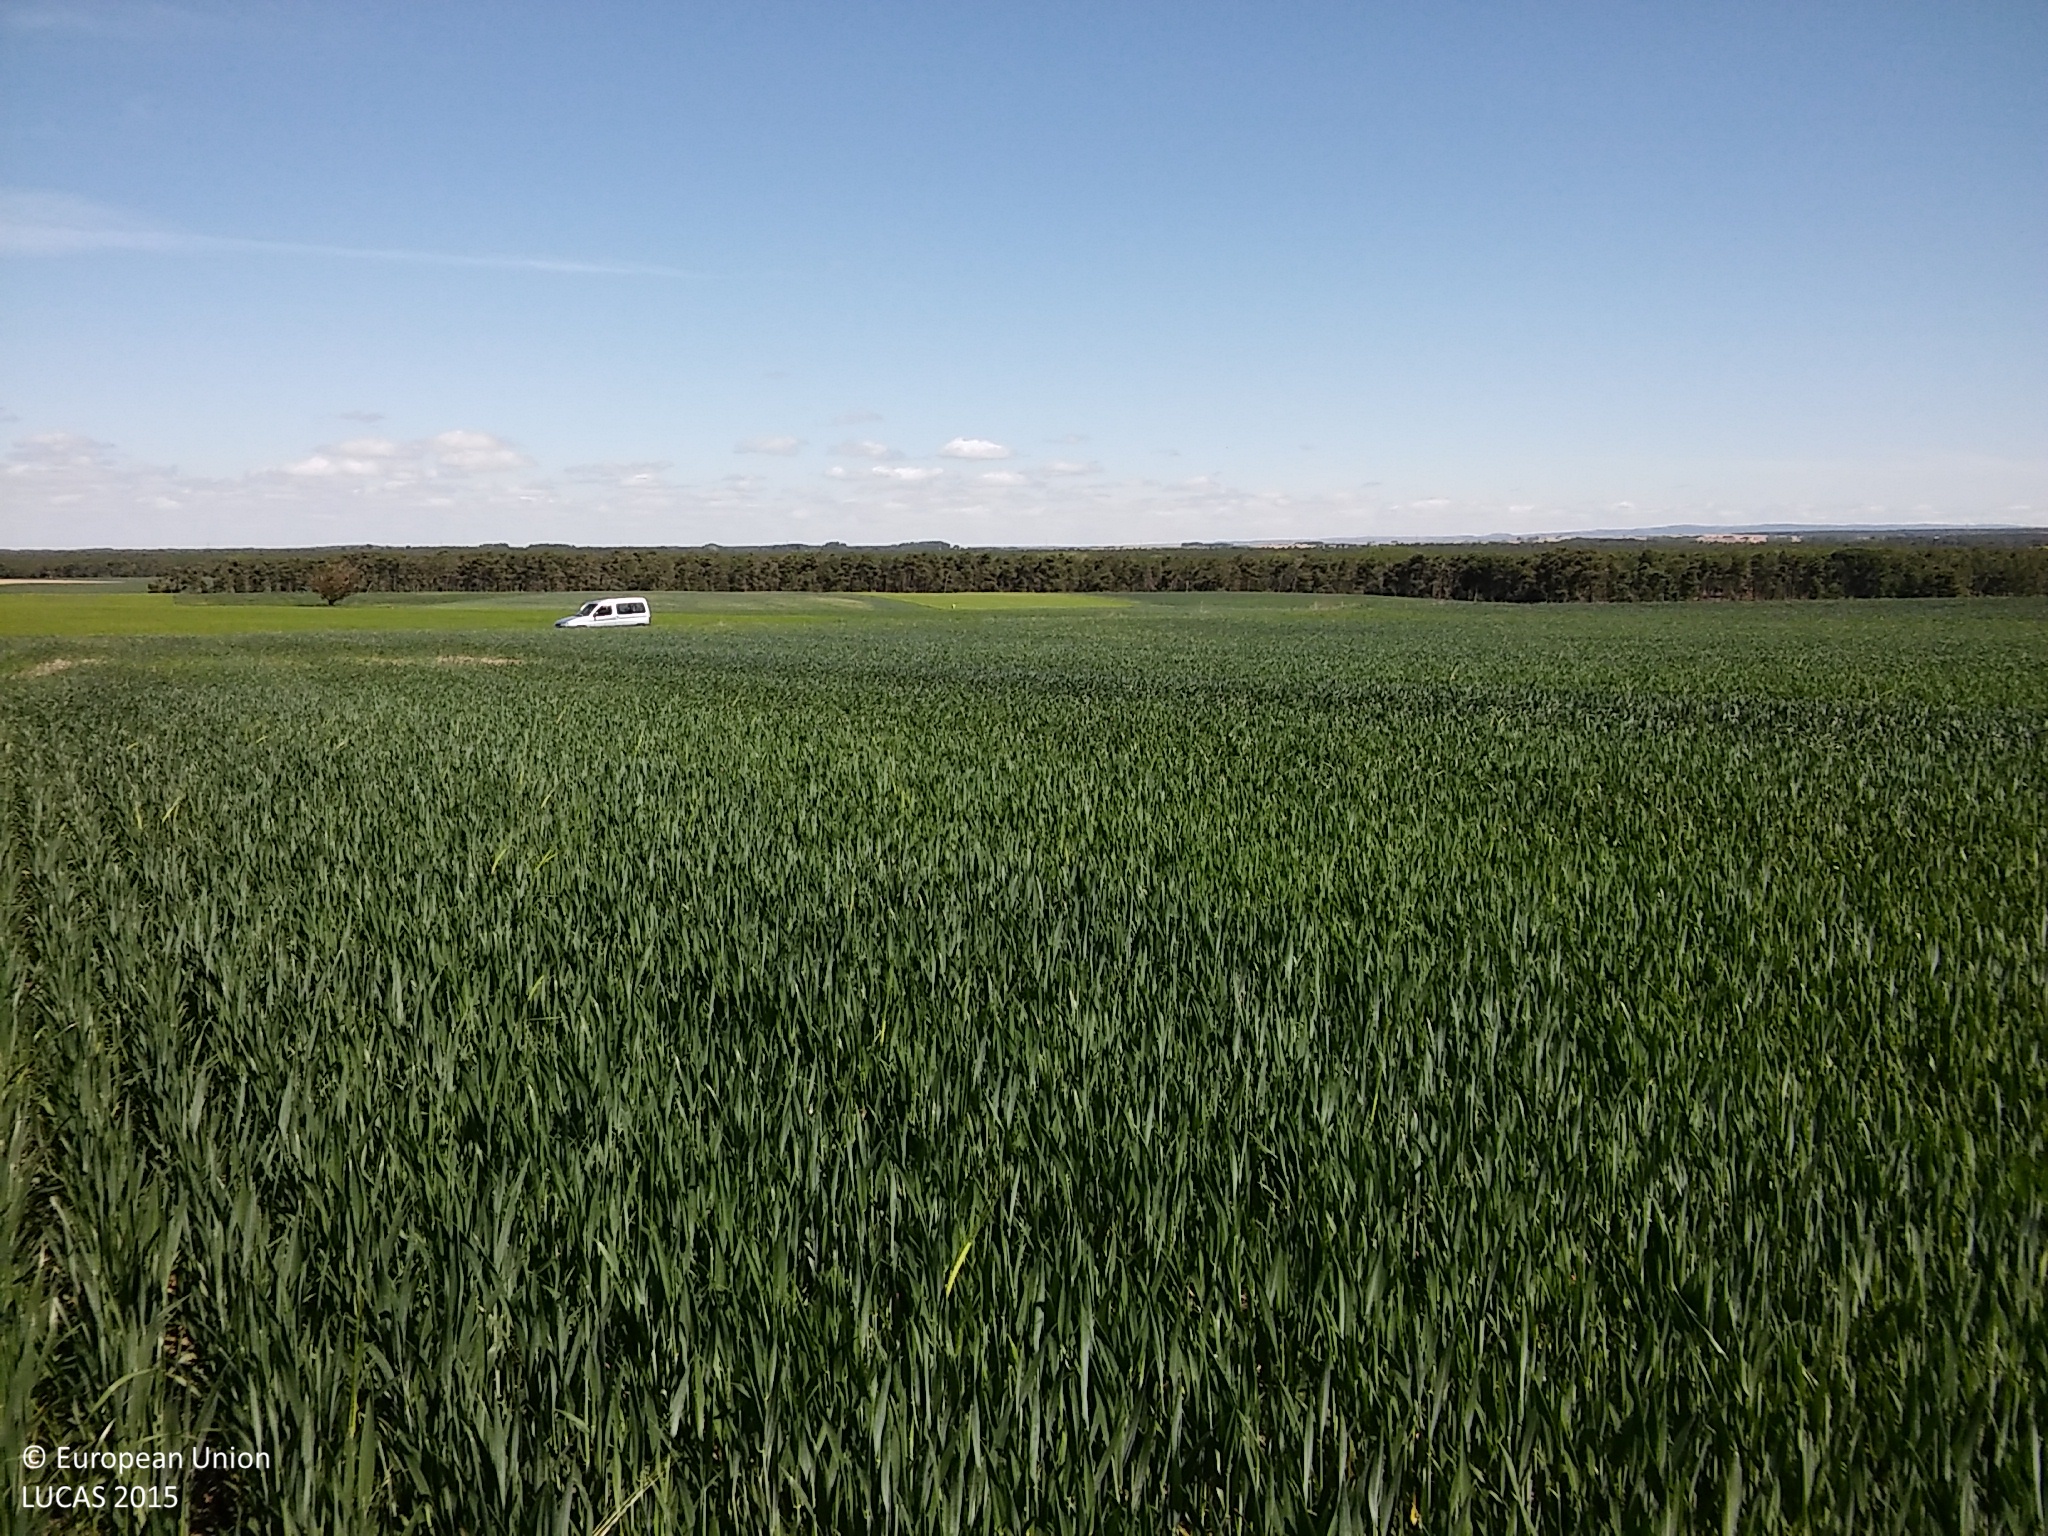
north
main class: Cropland
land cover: Common wheat
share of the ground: > 75 %
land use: Agriculture (excluding fallow land and kitchen gardens)
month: May
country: ES
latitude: 41.1870
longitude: -3.9643
